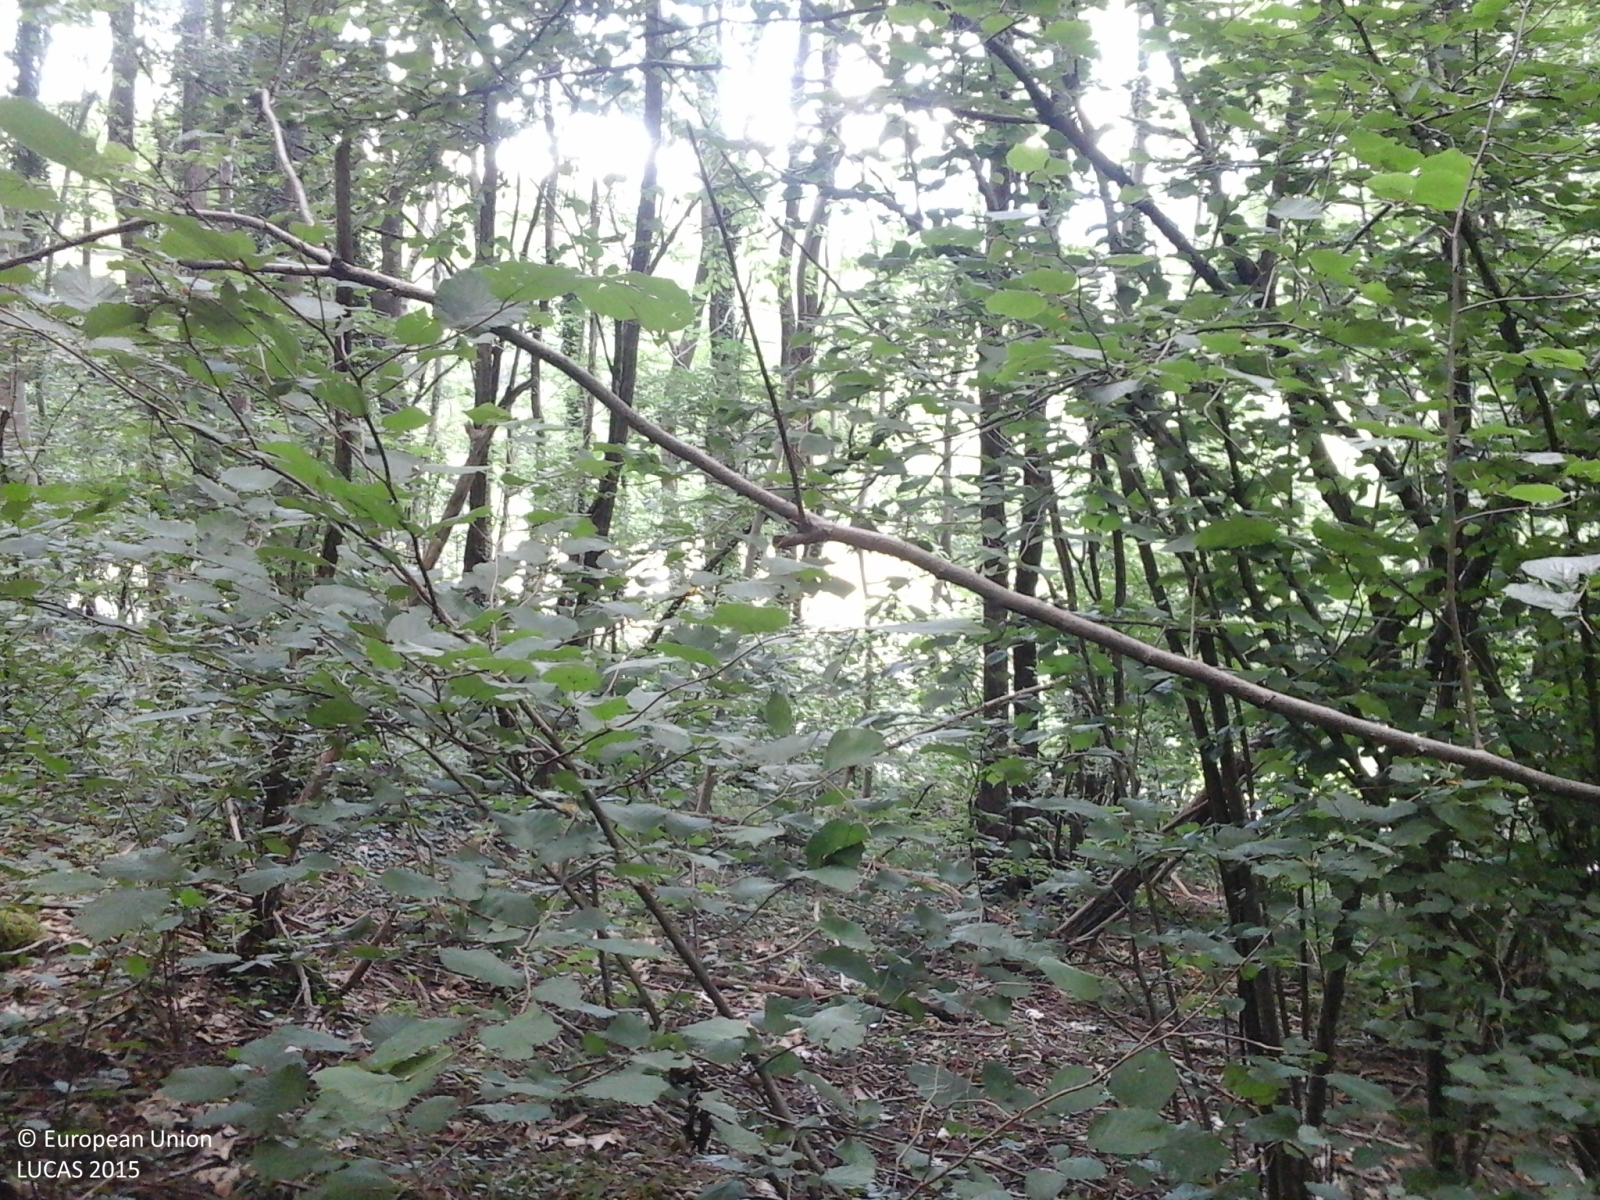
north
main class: Woodland
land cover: Broadleaved woodland
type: thermophilous deciduous forest
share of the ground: > 75 %
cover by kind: broadleaved forest trees 100 %
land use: Forestry
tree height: > 5 m
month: June
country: IT
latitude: 45.8208
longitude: 8.7020
